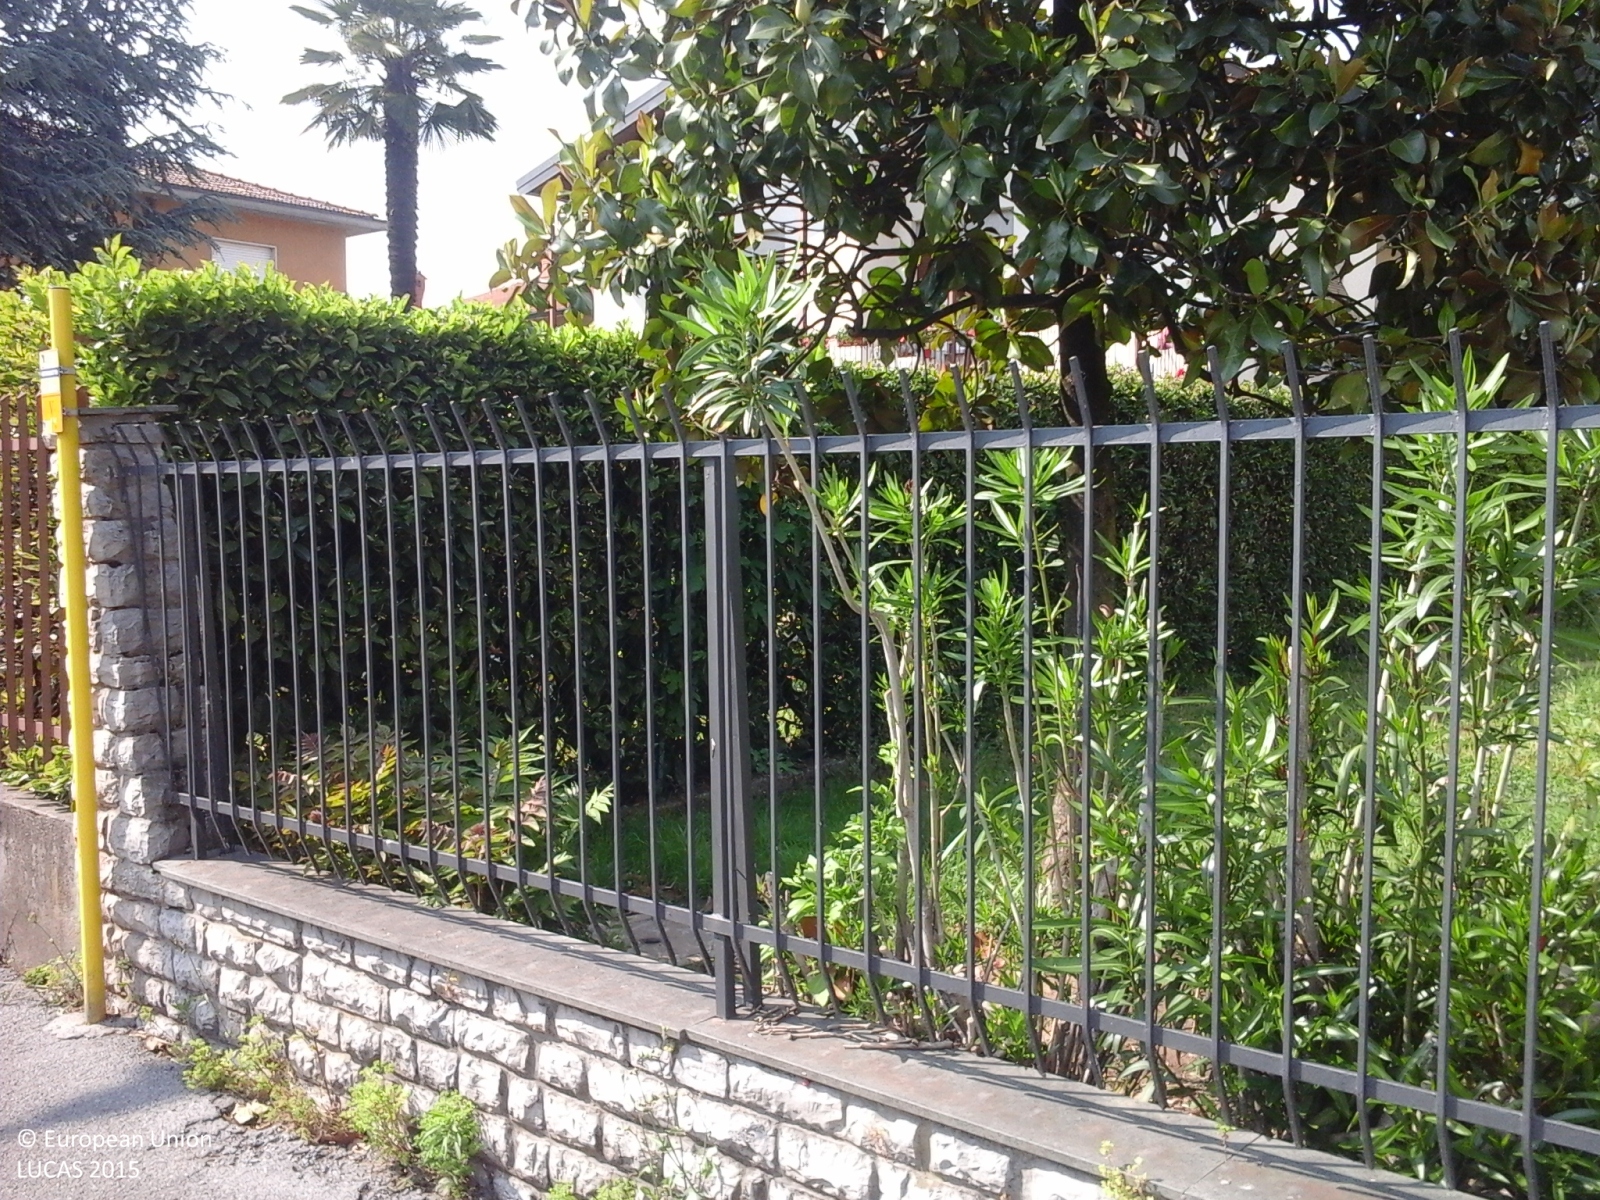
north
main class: Grassland
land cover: Grassland with sparse tree/shrub cover
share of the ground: > 75 %
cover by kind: herbaceous plants 90 %, broadleaved forest trees 5 %, shrubs 5 %
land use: Residential
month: May
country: IT
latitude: 45.6480
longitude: 9.6541
